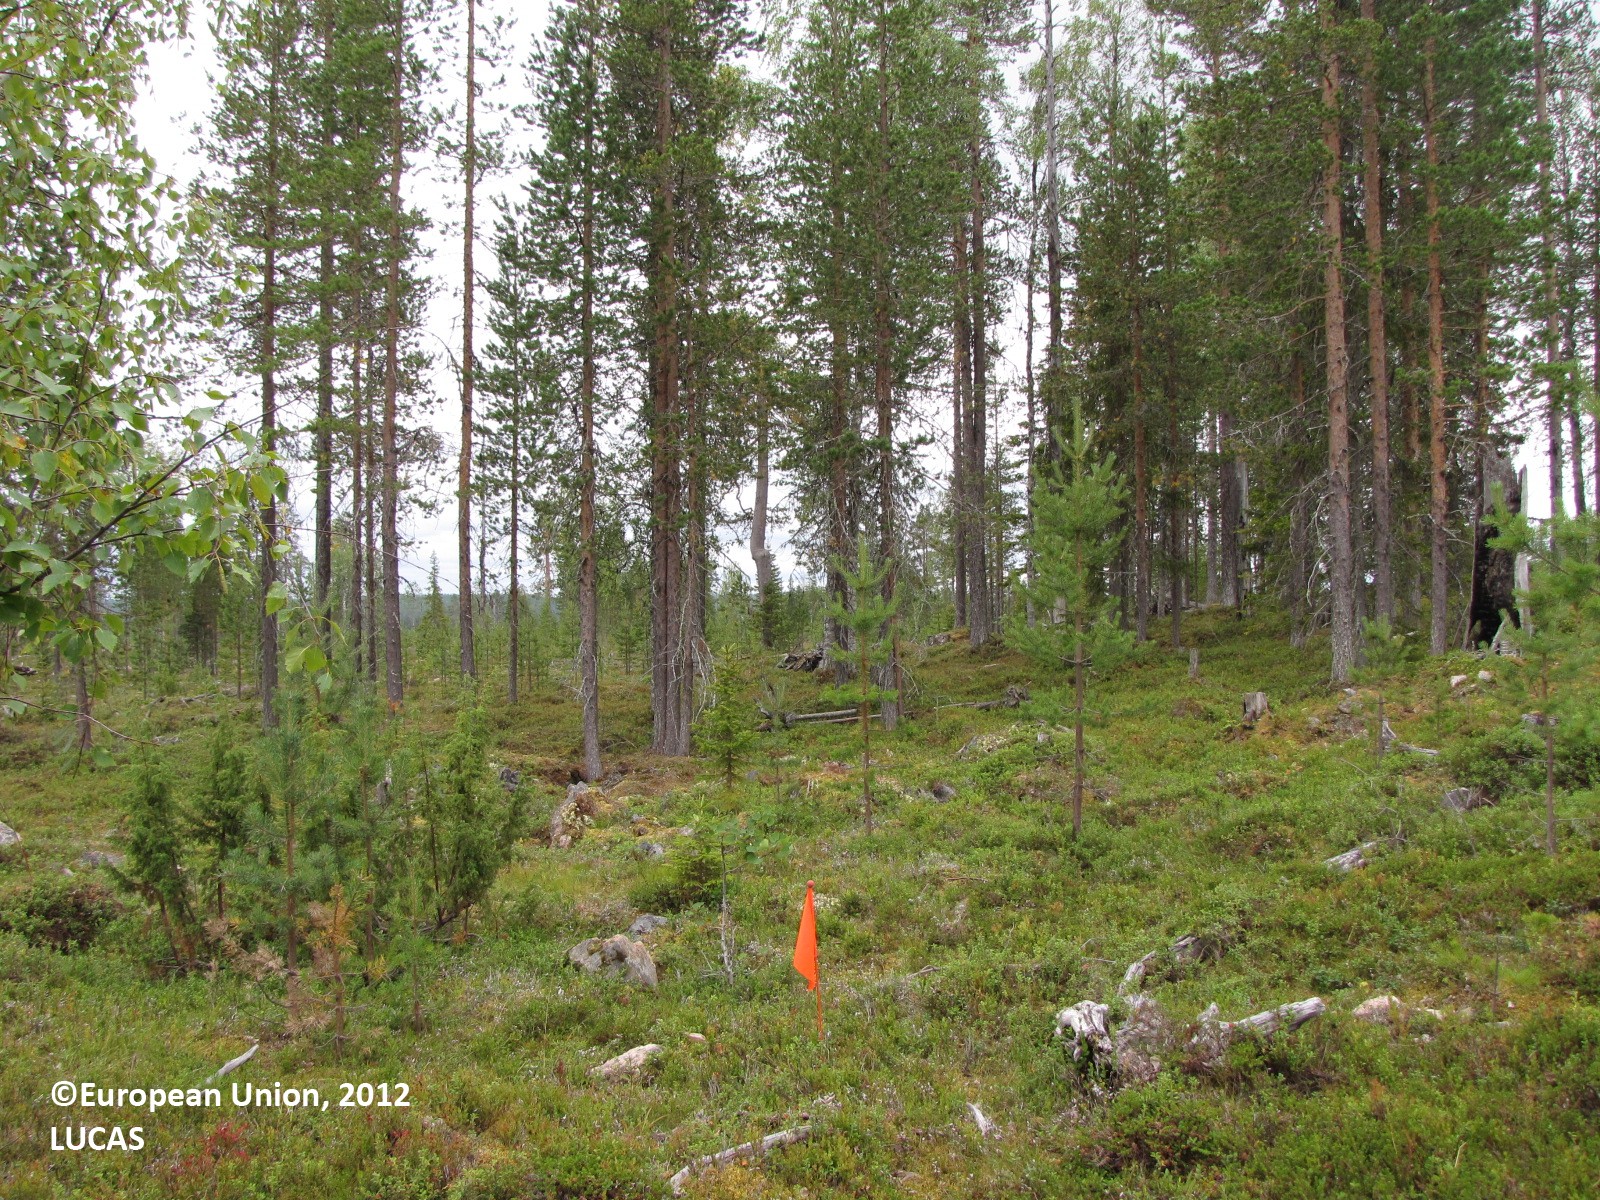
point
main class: Woodland
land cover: Pine dominated mixed woodland
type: boreal forest
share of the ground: 25 - 50 %
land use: Forestry
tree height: > 5 m
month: August
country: FI
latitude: 67.0910
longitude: 25.3143
